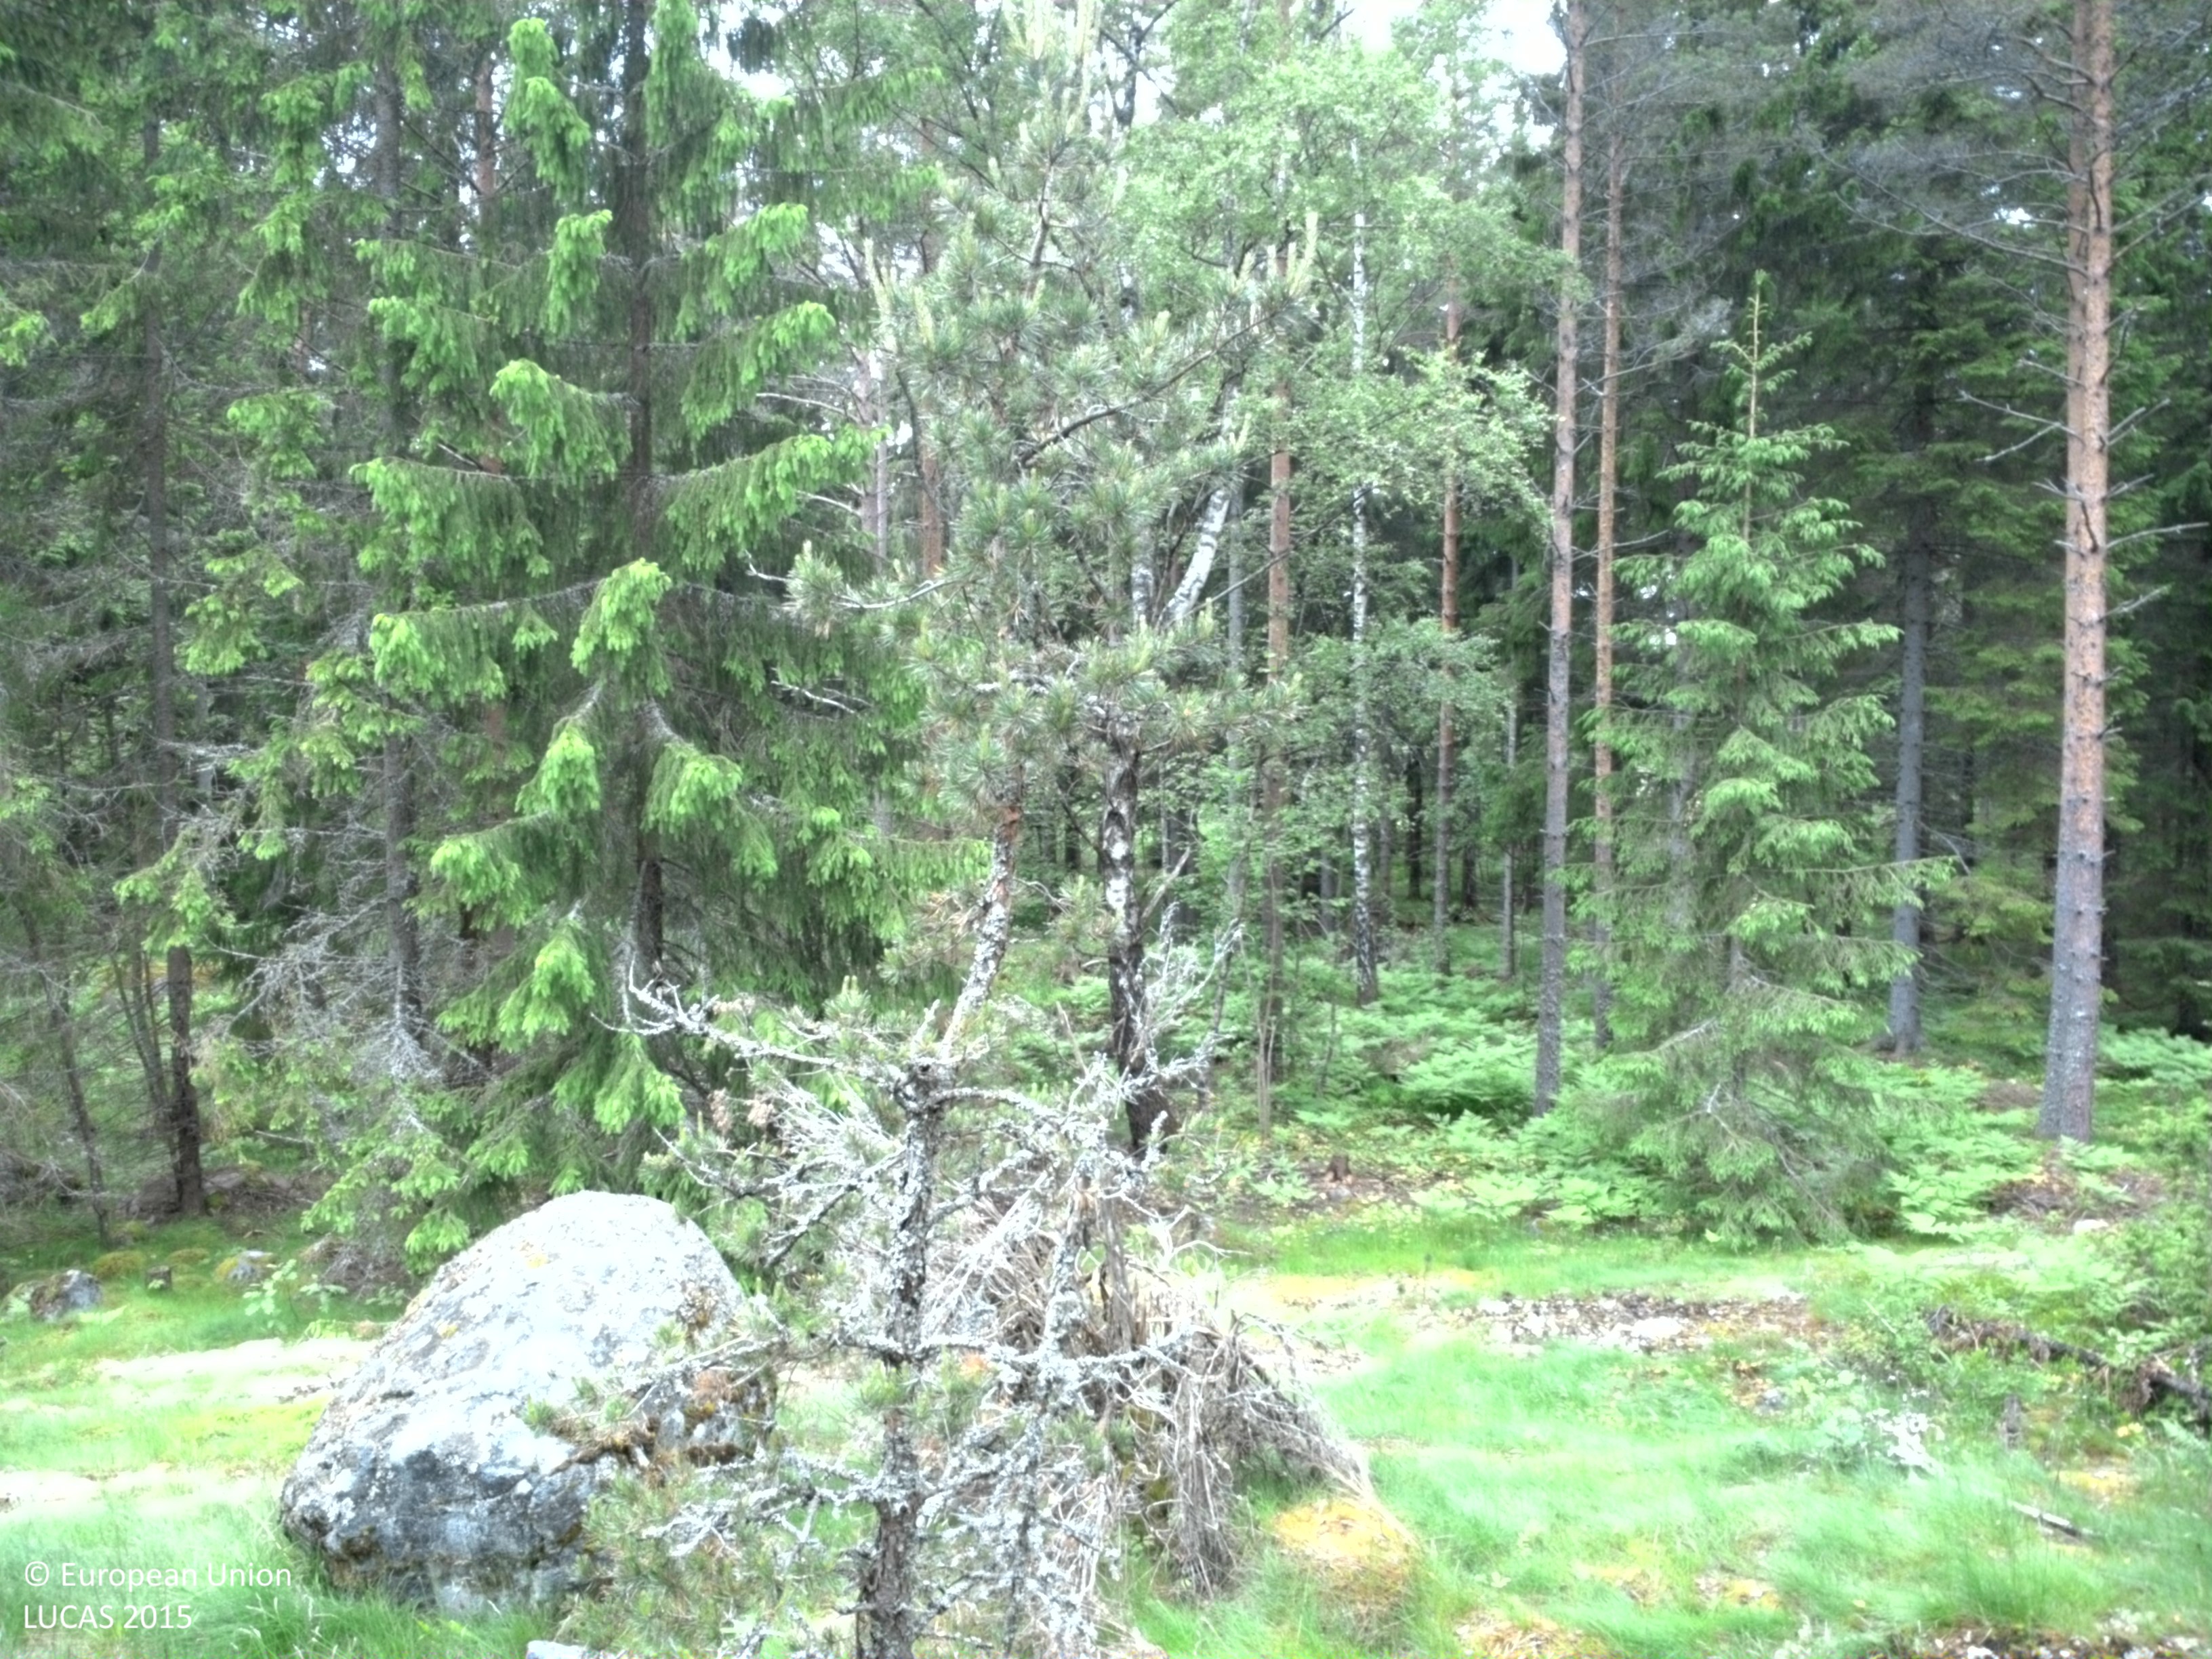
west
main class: Woodland
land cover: Pine dominated coniferous woodland
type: boreal forest
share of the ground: 10 - 25 %
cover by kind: herbaceous plants 25 %, lichens and mosses 25 %, consolidated bare surface 25 %, coniferous forest trees 20 %, broadleaved forest trees 5 %
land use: Forestry
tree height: > 5 m
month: June
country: SE
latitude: 59.6993
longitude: 18.6178
